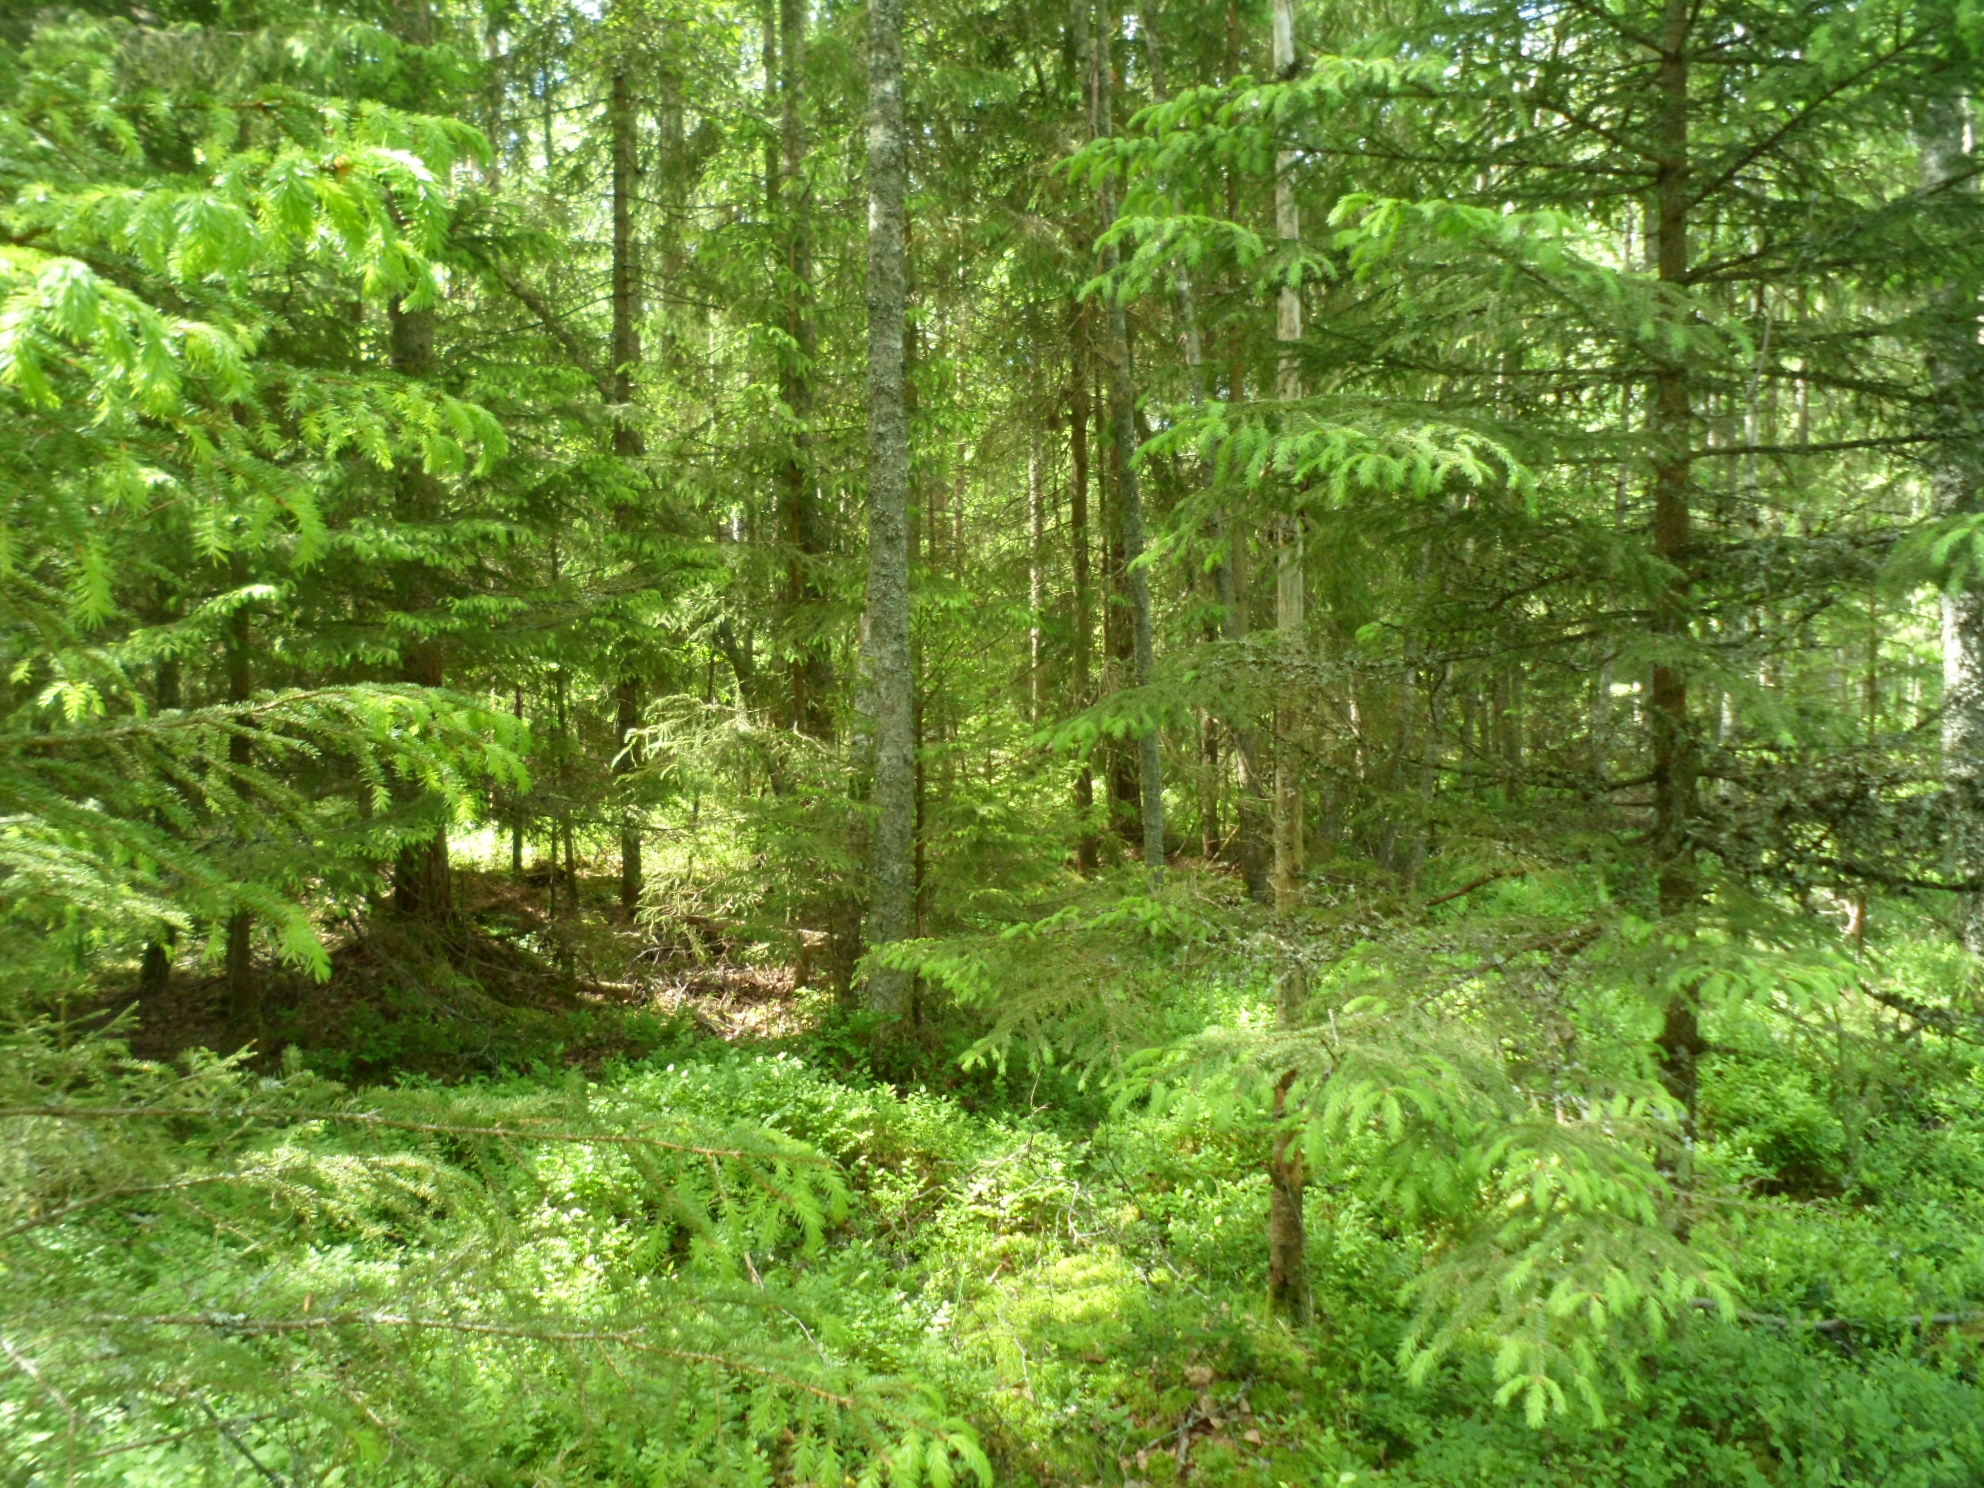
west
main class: Woodland
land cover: Spruce dominated mixed woodland
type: boreal forest
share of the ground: 50 - 75 %
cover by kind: coniferous forest trees 35 %, broadleaved forest trees 30 %, shrubs 25 %, herbaceous plants 5 %, lichens and mosses 5 %
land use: Forestry
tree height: > 5 m
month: June
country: SE
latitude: 57.0510
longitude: 14.3320
